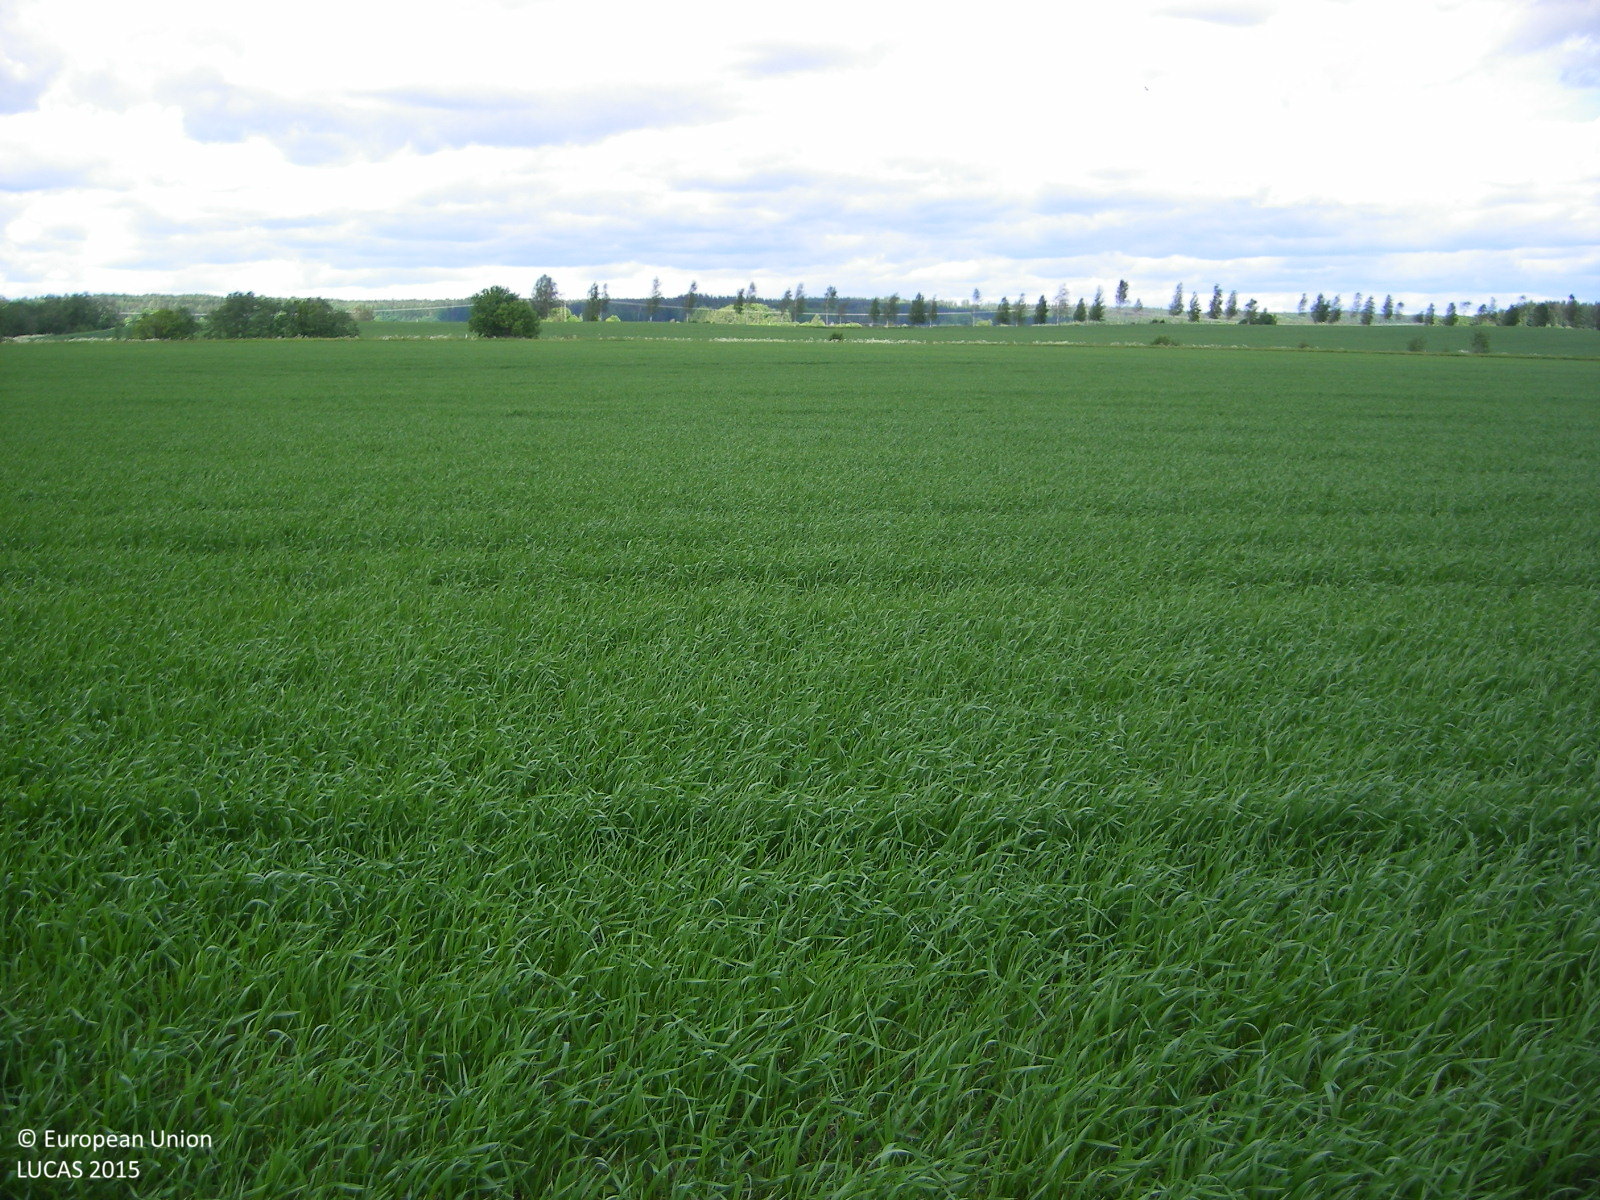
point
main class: Cropland
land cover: Common wheat
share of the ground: > 75 %
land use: Agriculture (excluding fallow land and kitchen gardens)
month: June
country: FI
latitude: 60.1850
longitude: 24.0737
